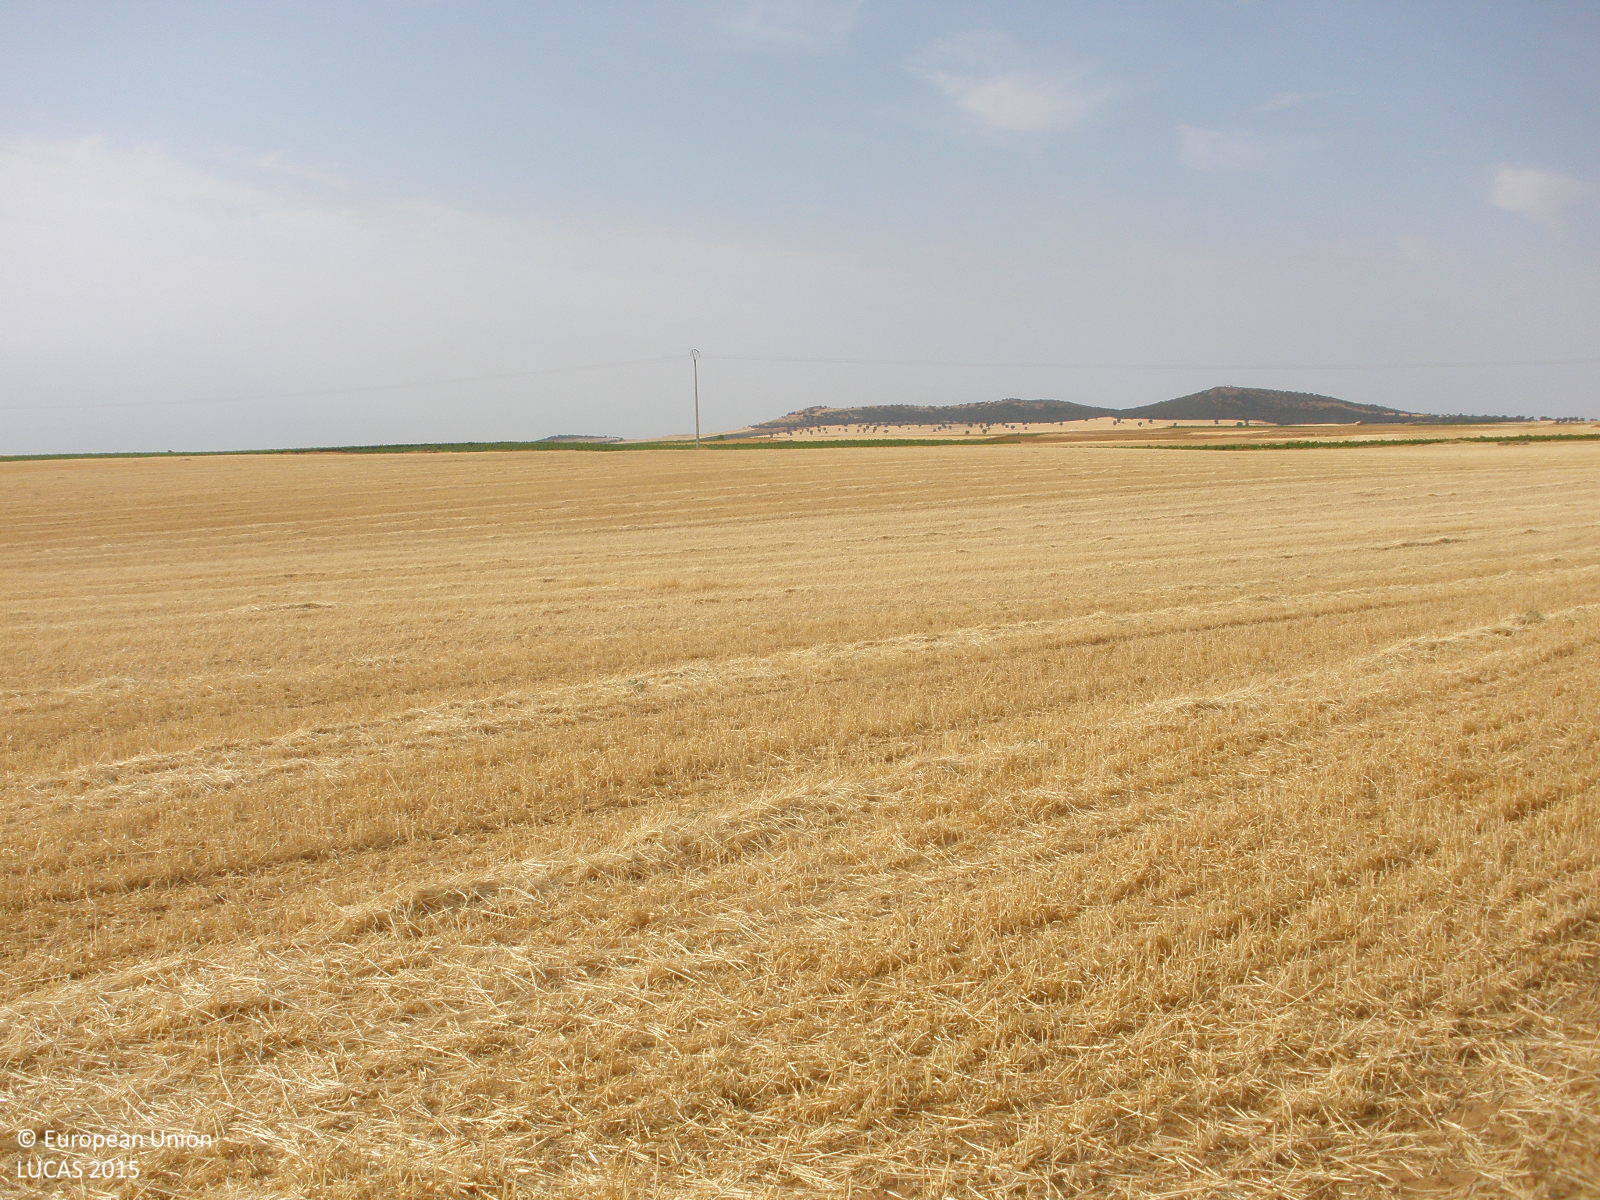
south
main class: Cropland
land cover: Barley
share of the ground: < 10 %
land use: Agriculture (excluding fallow land and kitchen gardens)
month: July
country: ES
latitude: 39.7912
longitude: -3.2074
